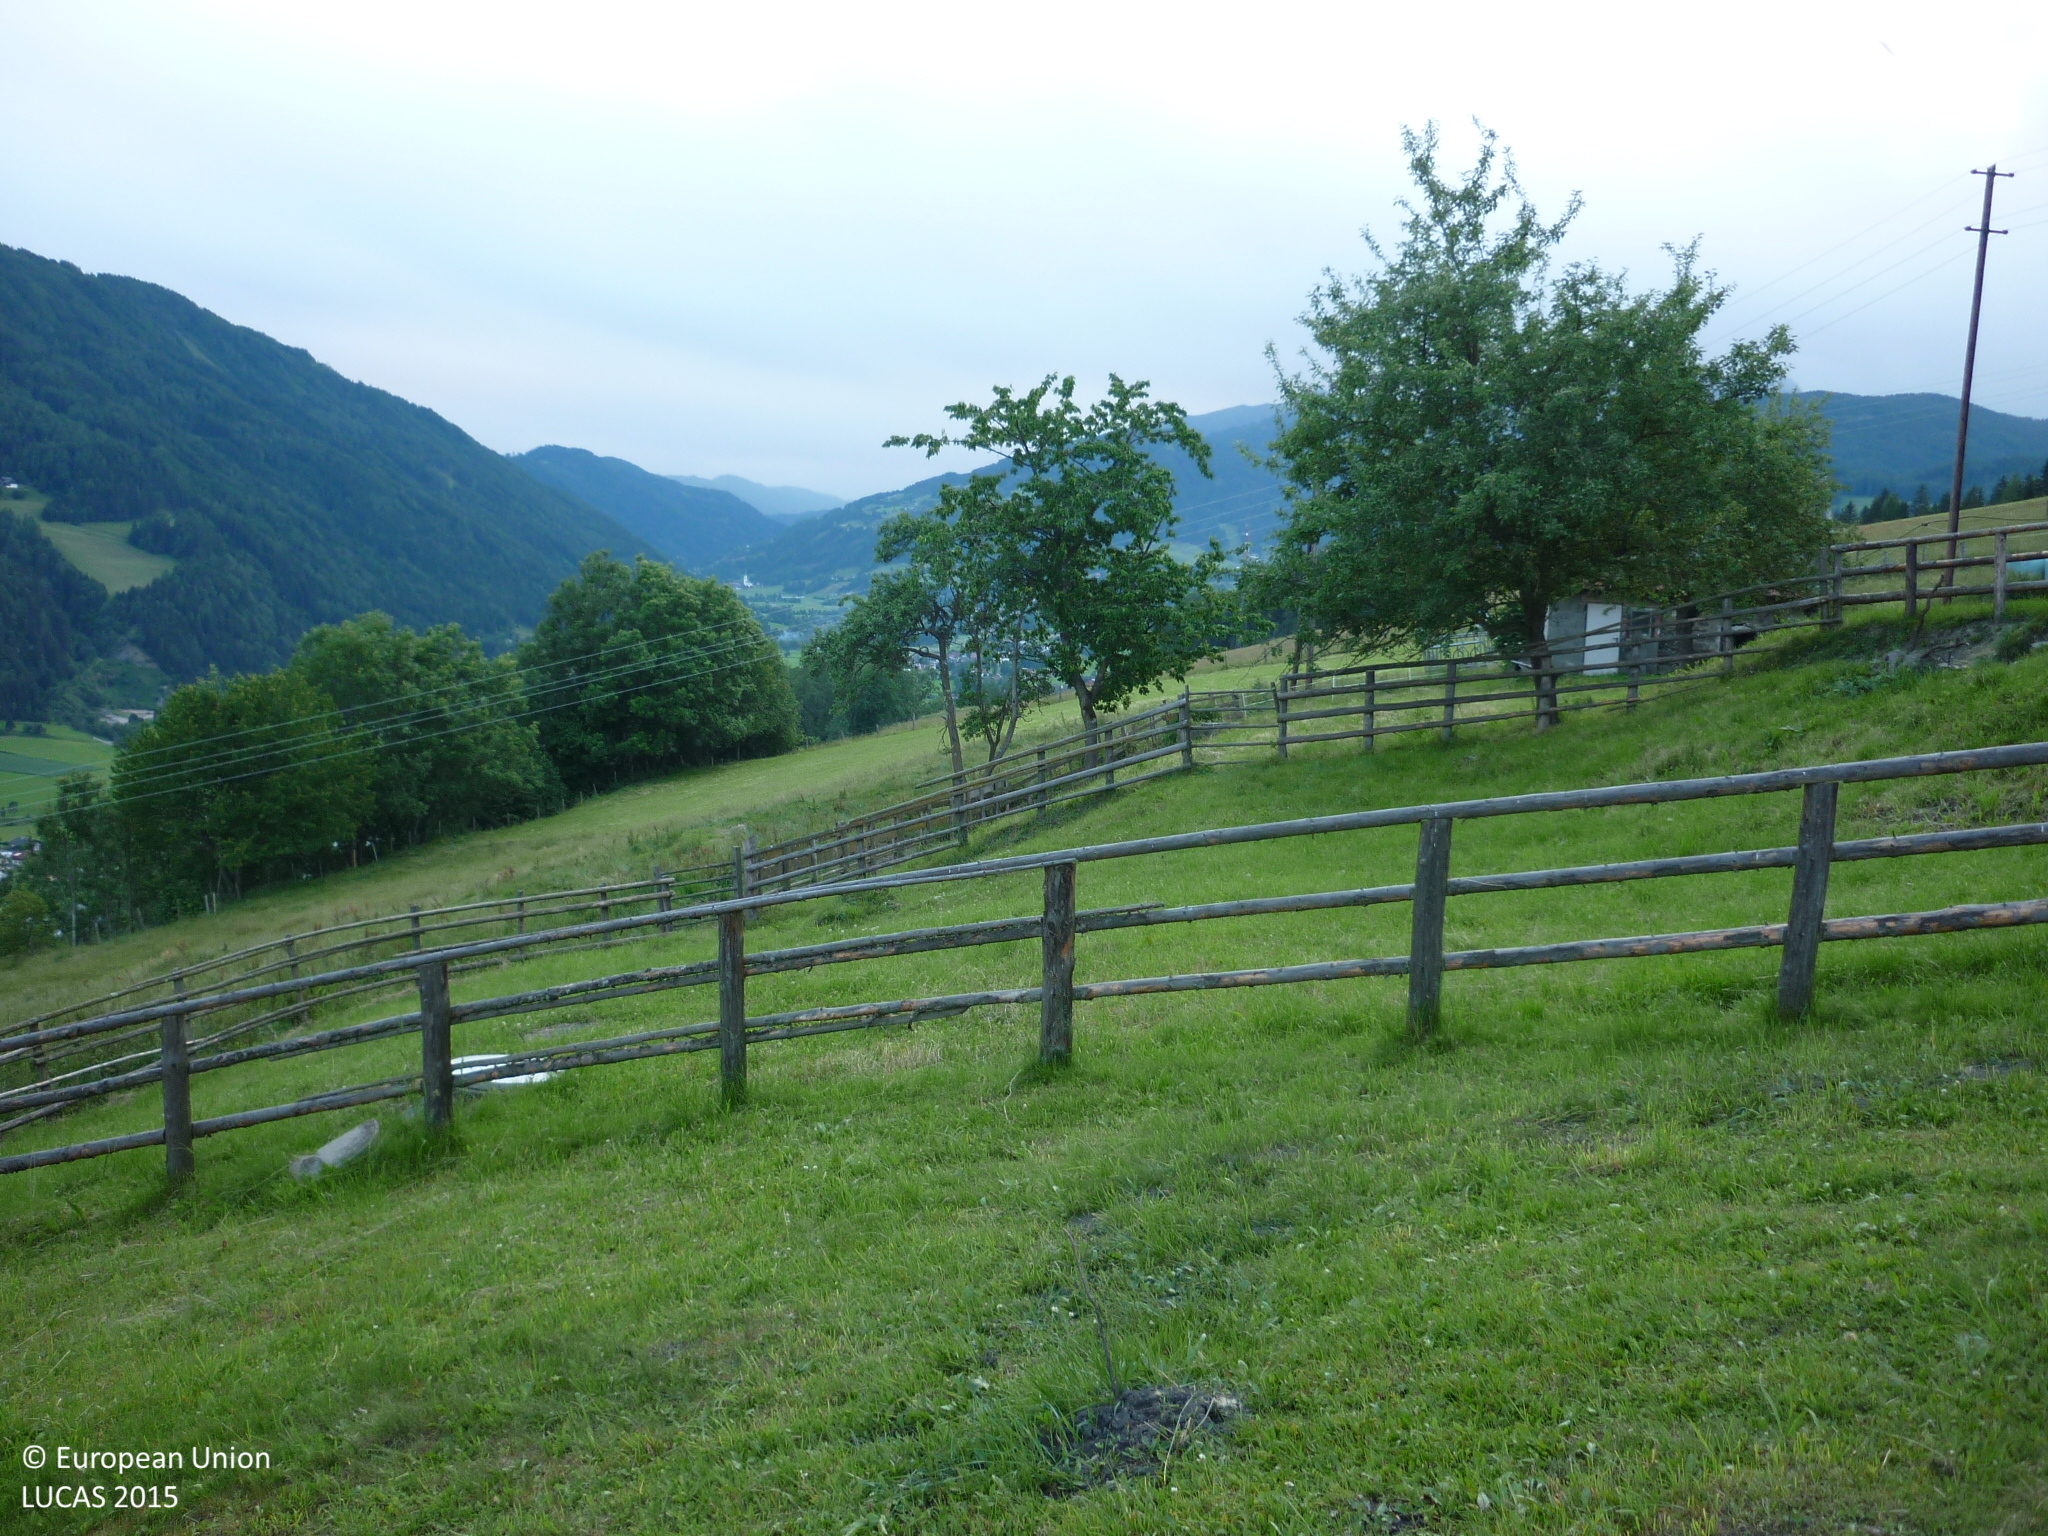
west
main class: Grassland
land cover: Grassland without tree/shrub cover
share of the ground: > 75 %
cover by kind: herbaceous plants 100 %
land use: Residential
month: June
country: AT
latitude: 47.1880
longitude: 14.2083
